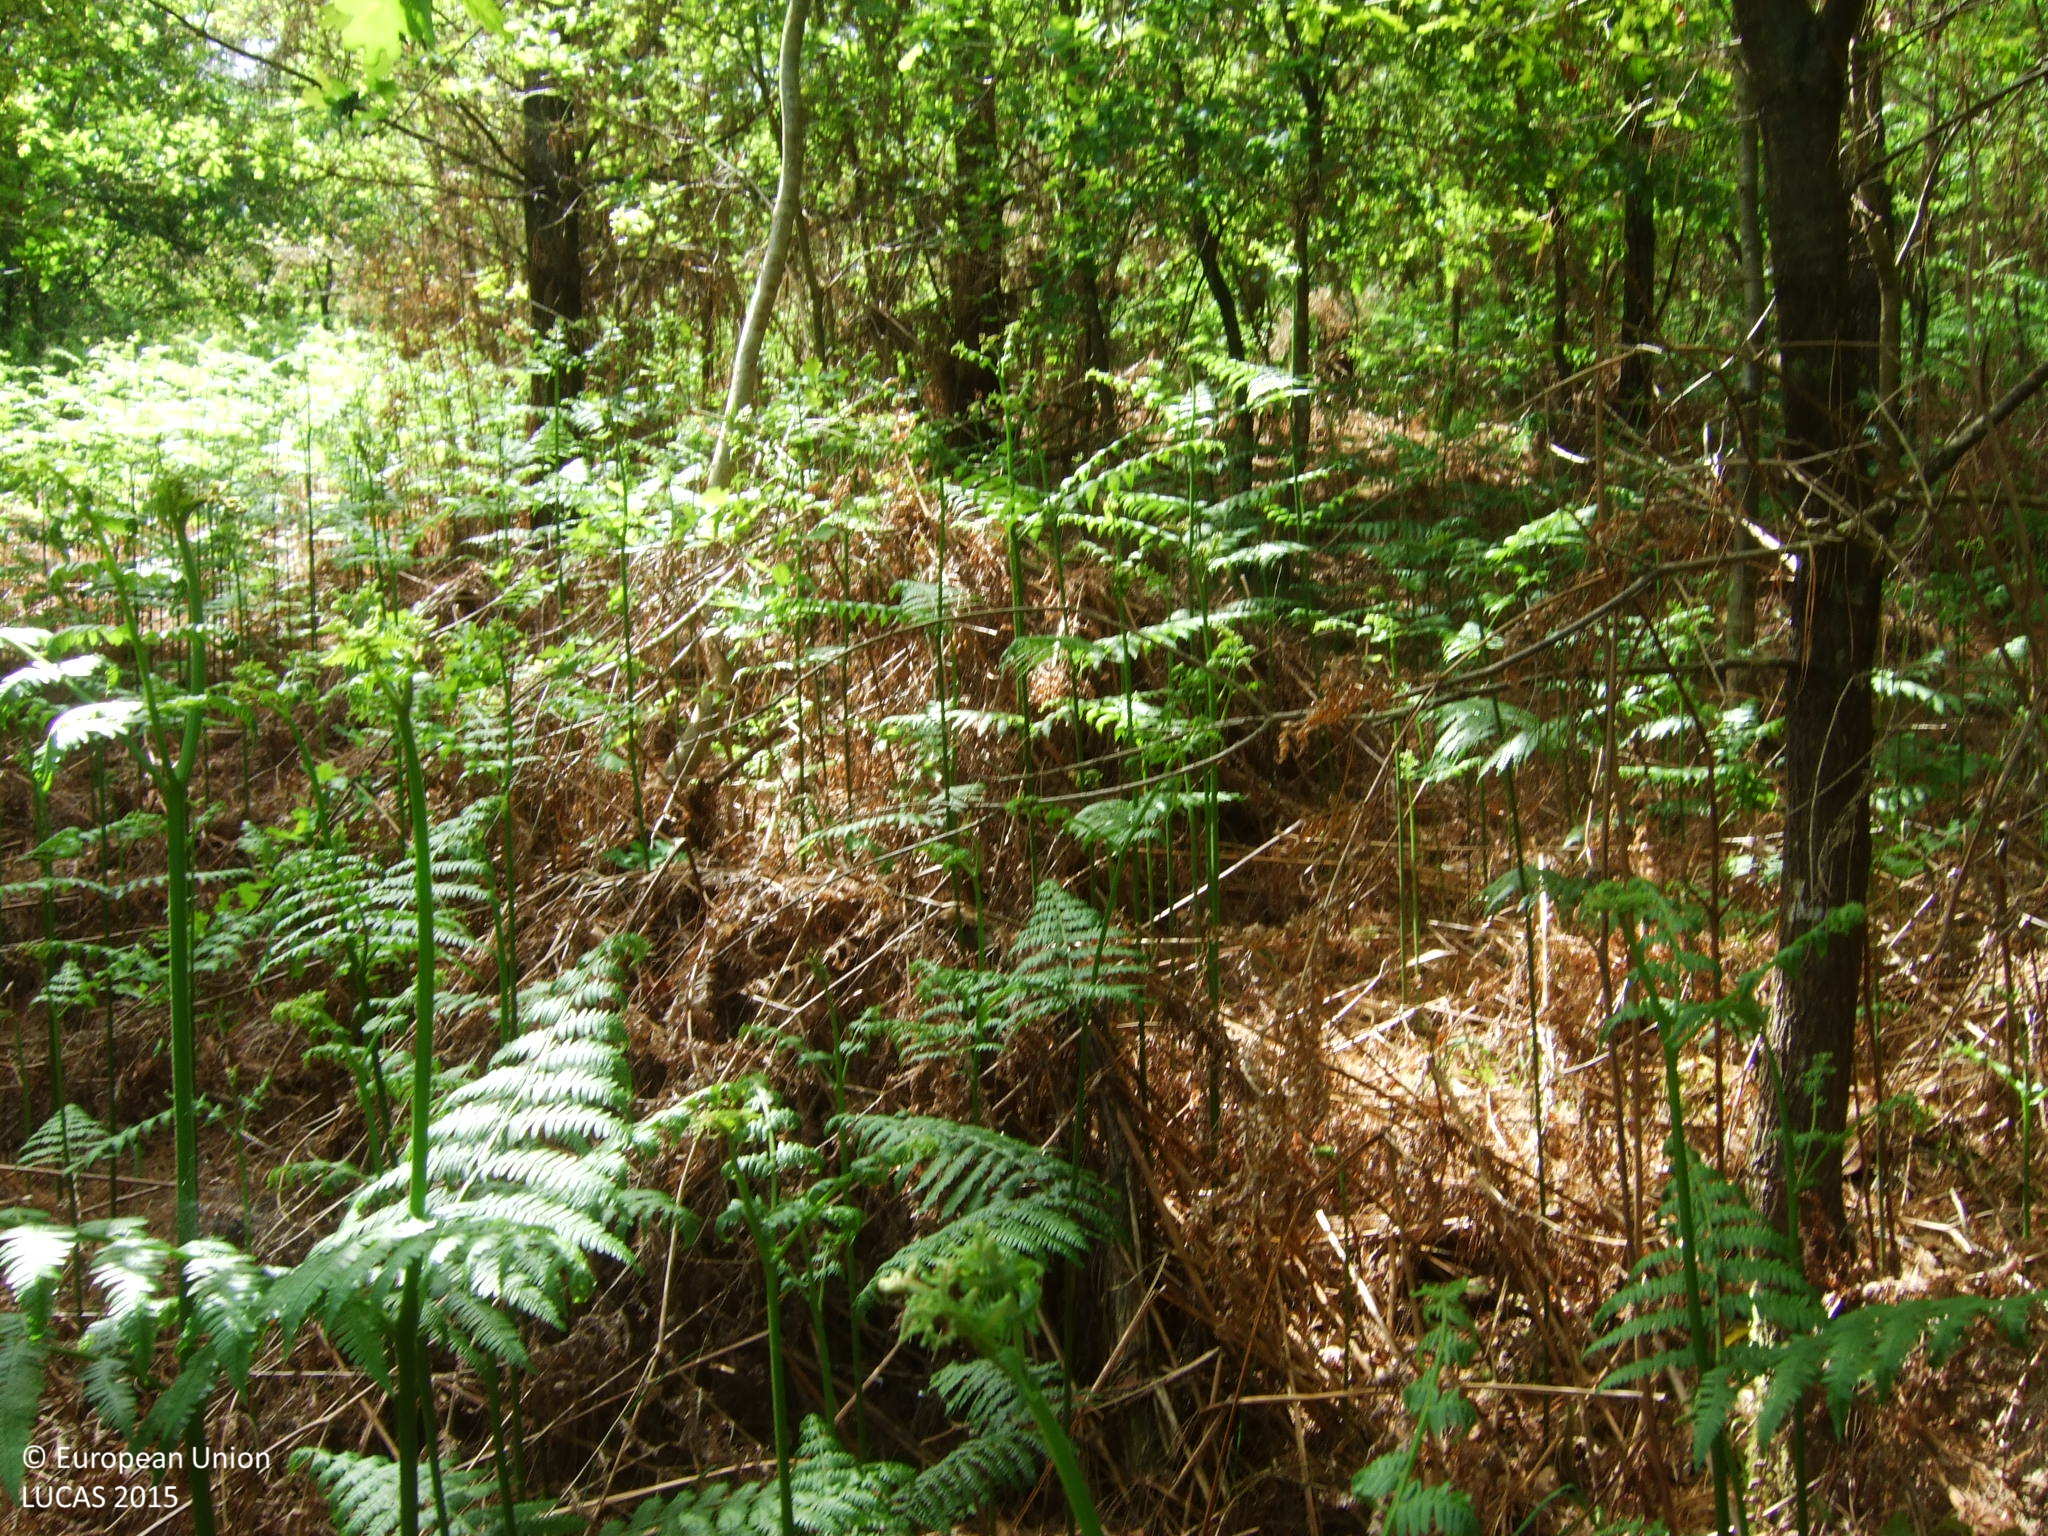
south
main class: Woodland
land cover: Broadleaved woodland
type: acidophilous oak and oak-birch forest
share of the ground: > 75 %
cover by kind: broadleaved forest trees 90 %, shrubs 10 %
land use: Forestry
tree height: > 5 m
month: May
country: ES
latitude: 42.9073
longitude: -7.3779
